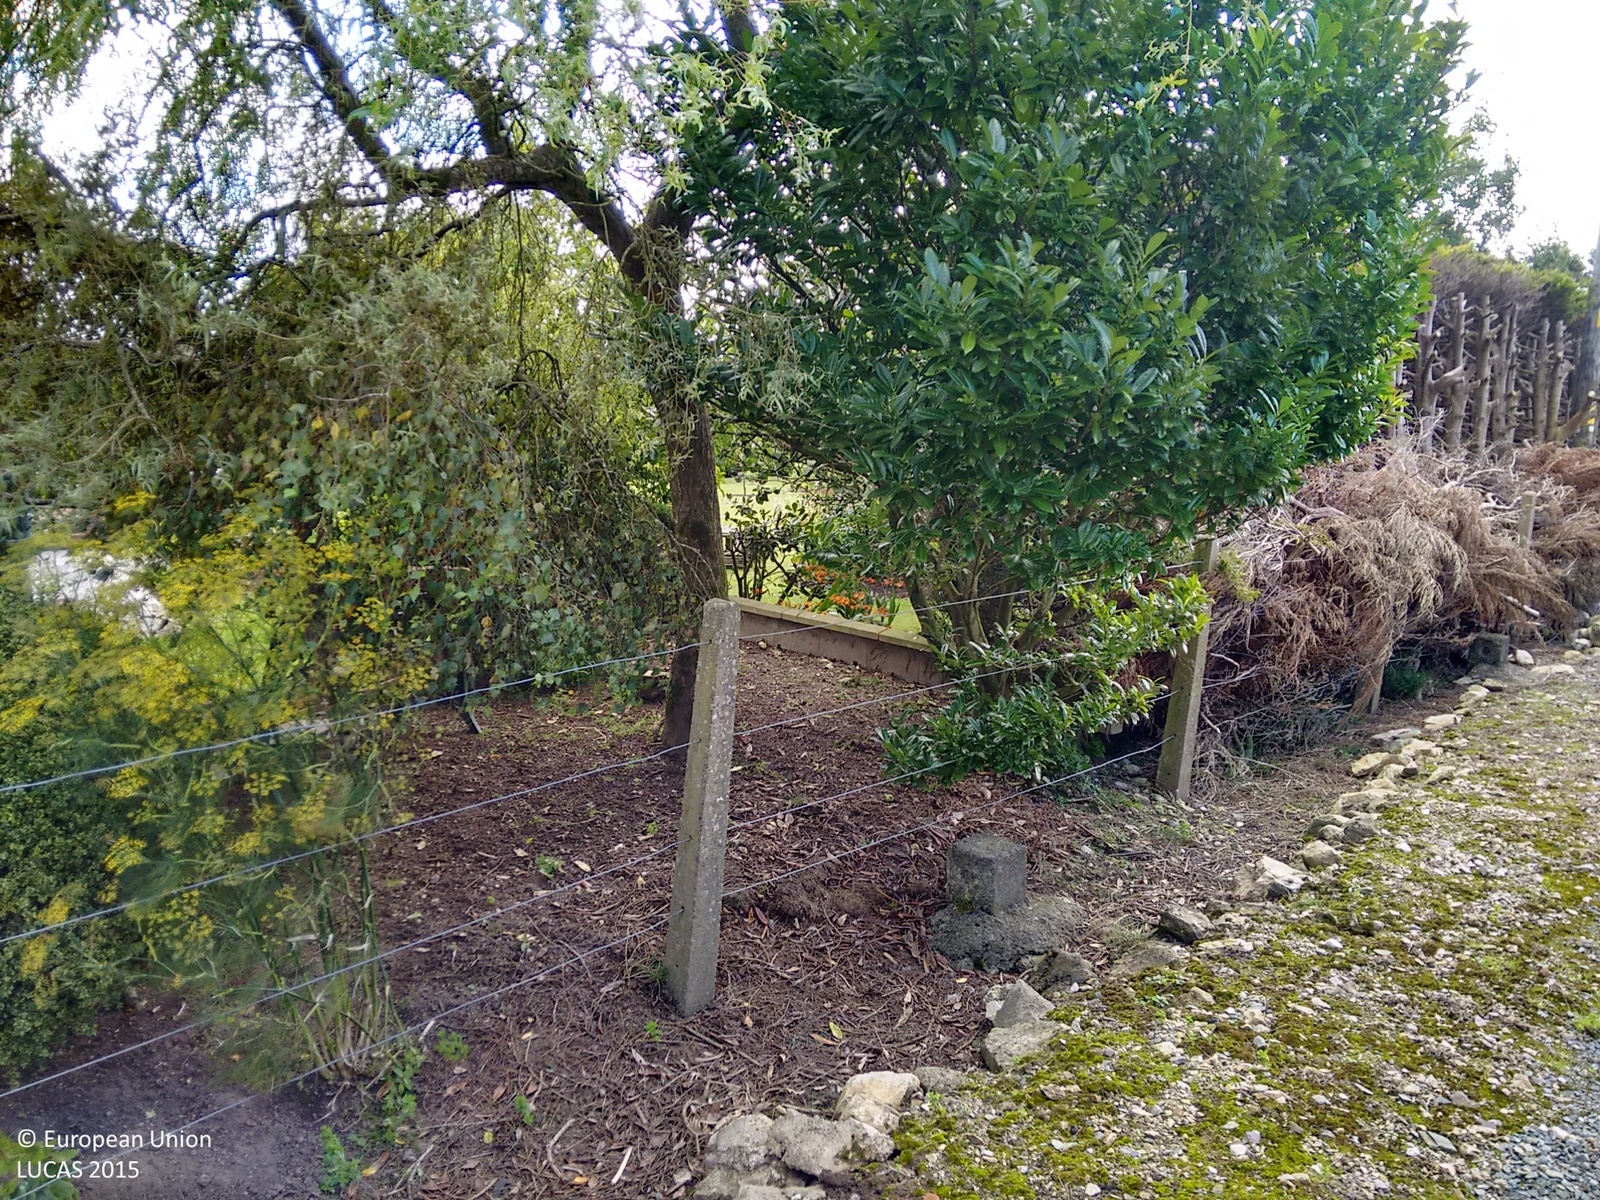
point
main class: Grassland
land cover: Grassland with sparse tree/shrub cover
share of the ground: > 75 %
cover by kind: herbaceous plants 95 %, broadleaved forest trees 5 %
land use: Residential
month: August
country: IE
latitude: 52.2903
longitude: -6.5346
